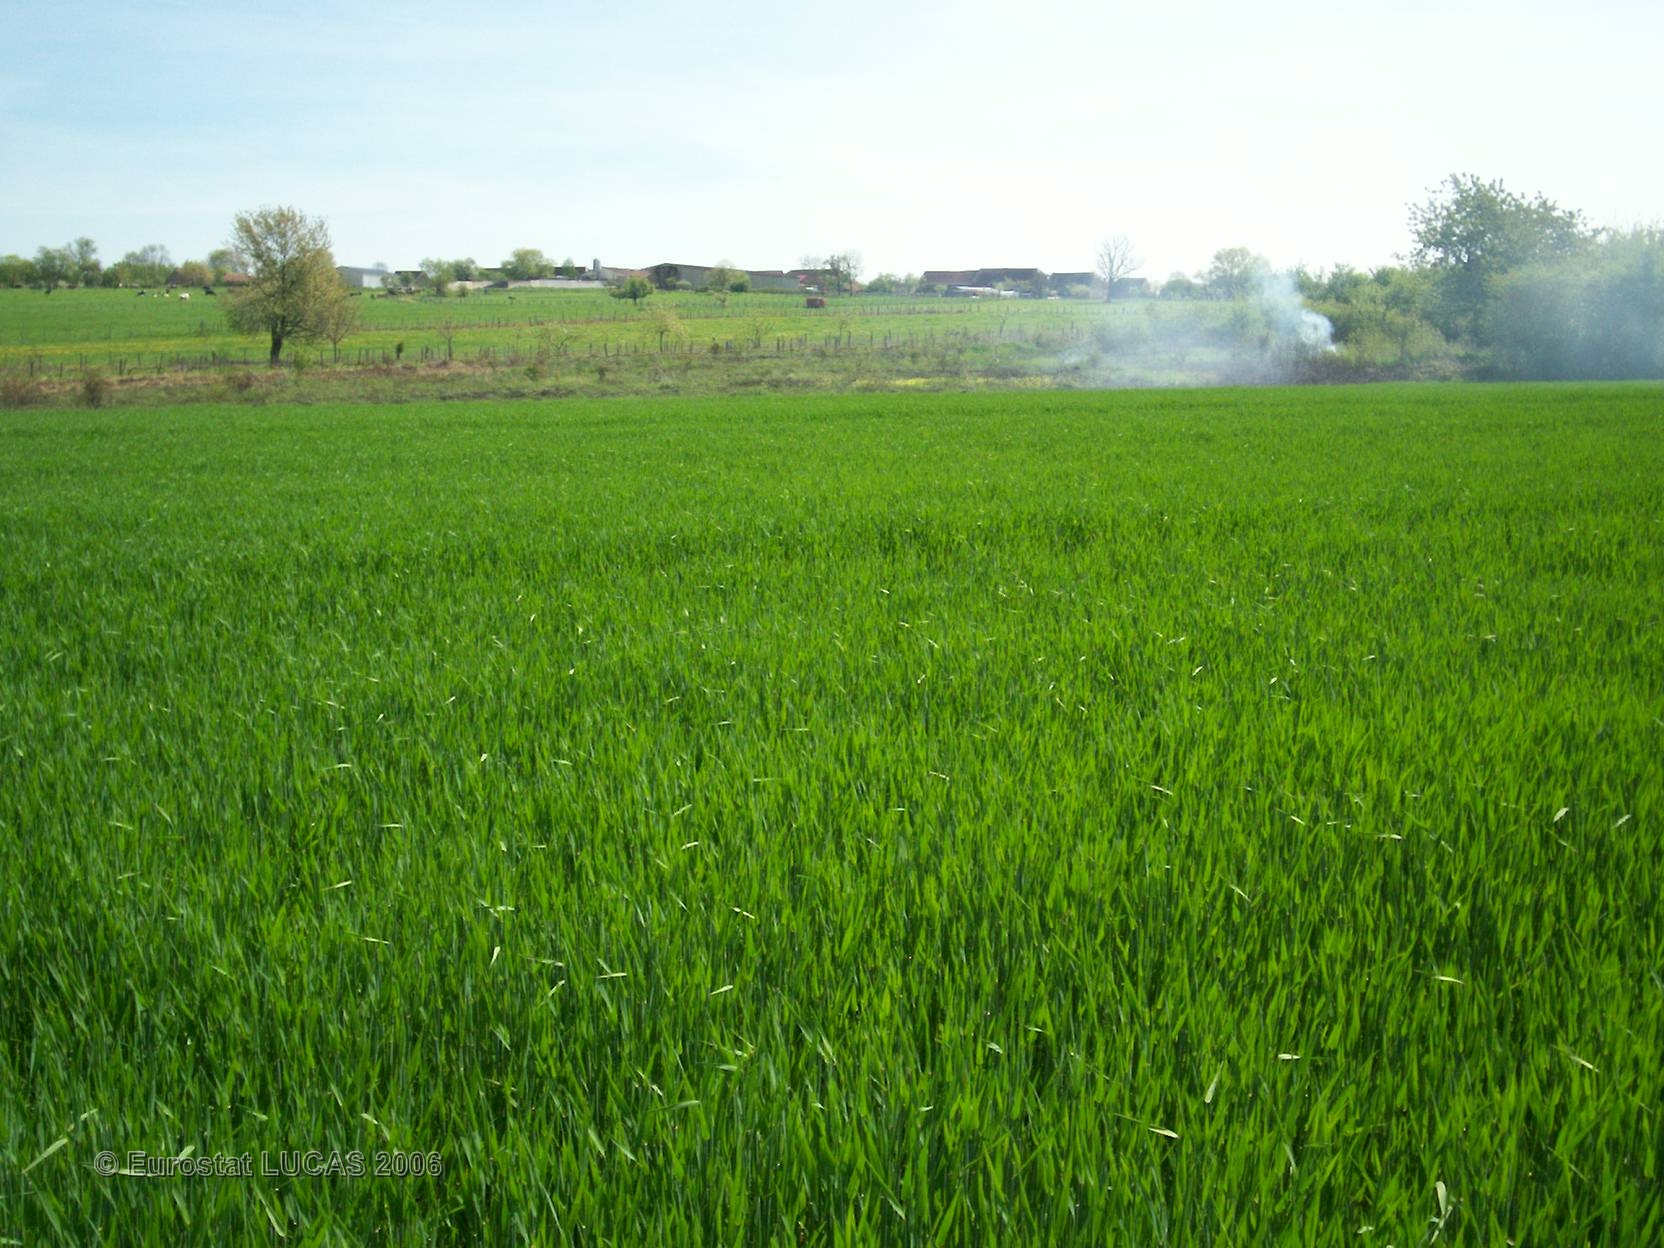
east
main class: Cropland
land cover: Barley
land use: Agriculture (excluding fallow land and kitchen gardens)
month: May
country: FR
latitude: 47.9719
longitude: 4.0359
